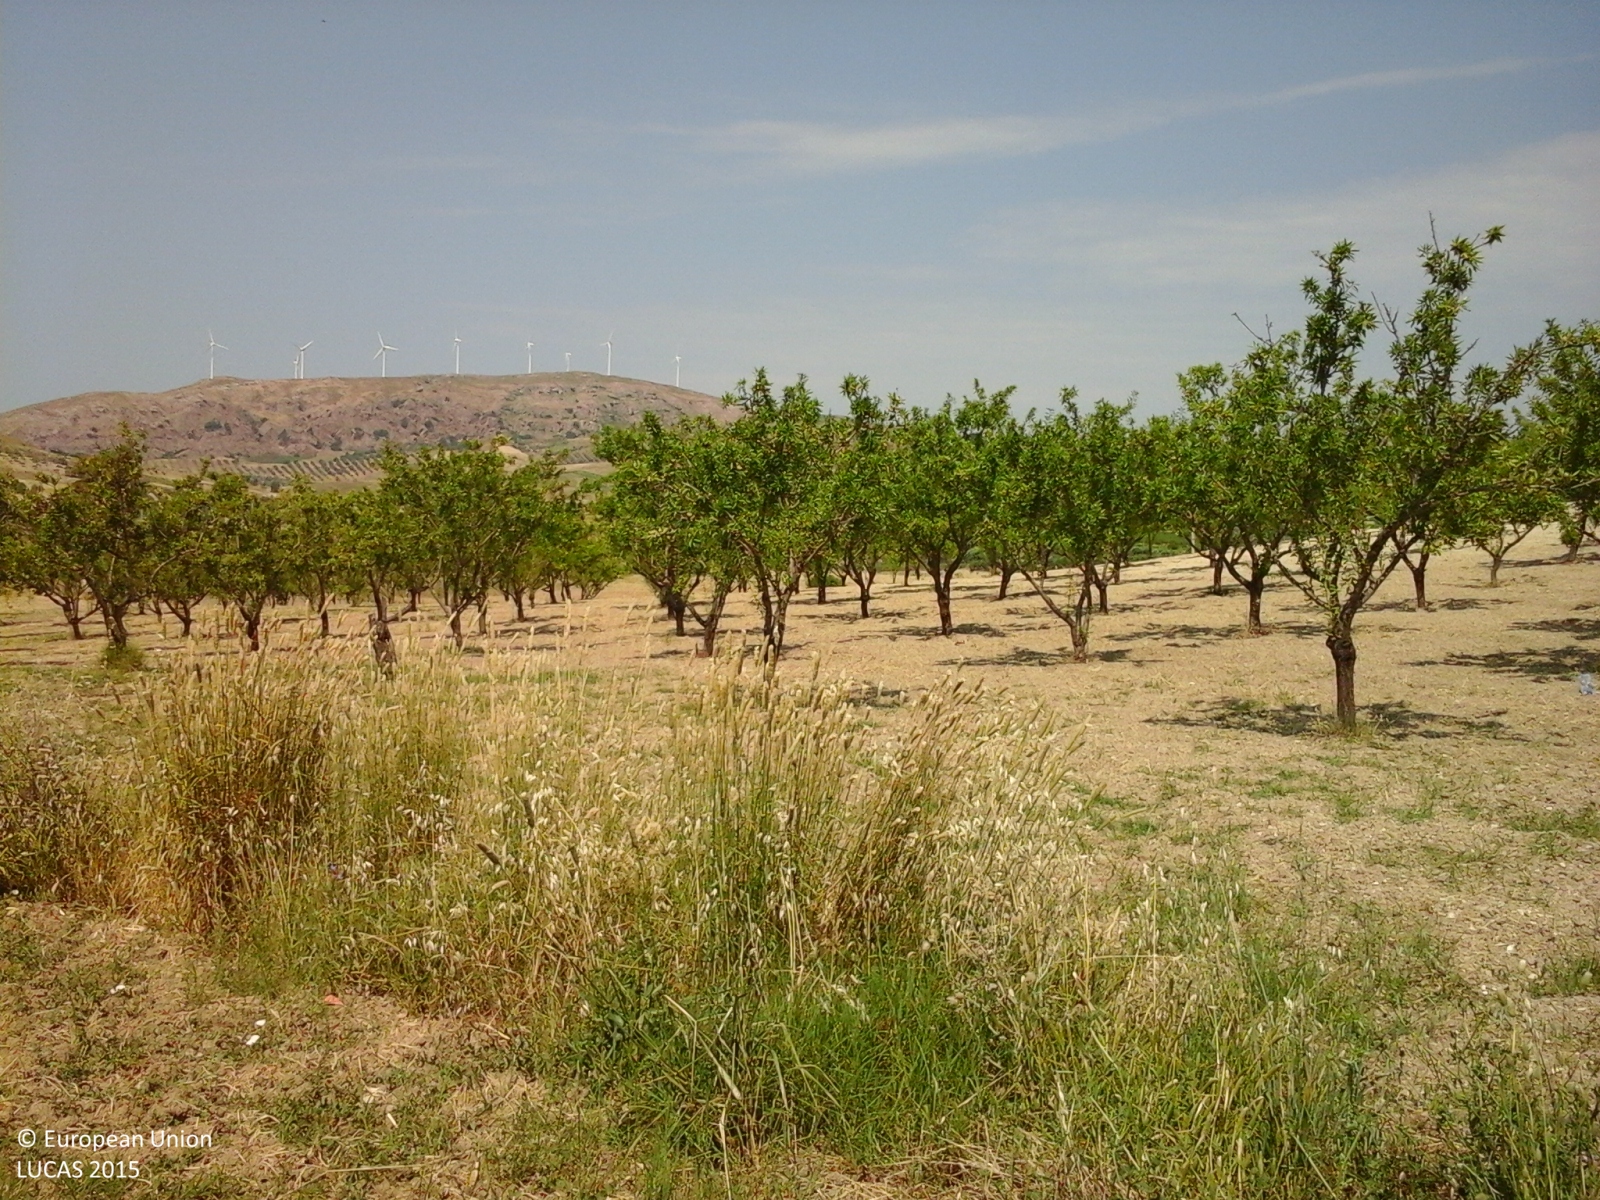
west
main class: Grassland
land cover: Grassland without tree/shrub cover
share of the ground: > 75 %
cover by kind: herbaceous plants 100 %
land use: Semi-natural and natural areas not in use
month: June
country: IT
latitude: 37.3385
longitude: 13.4832
